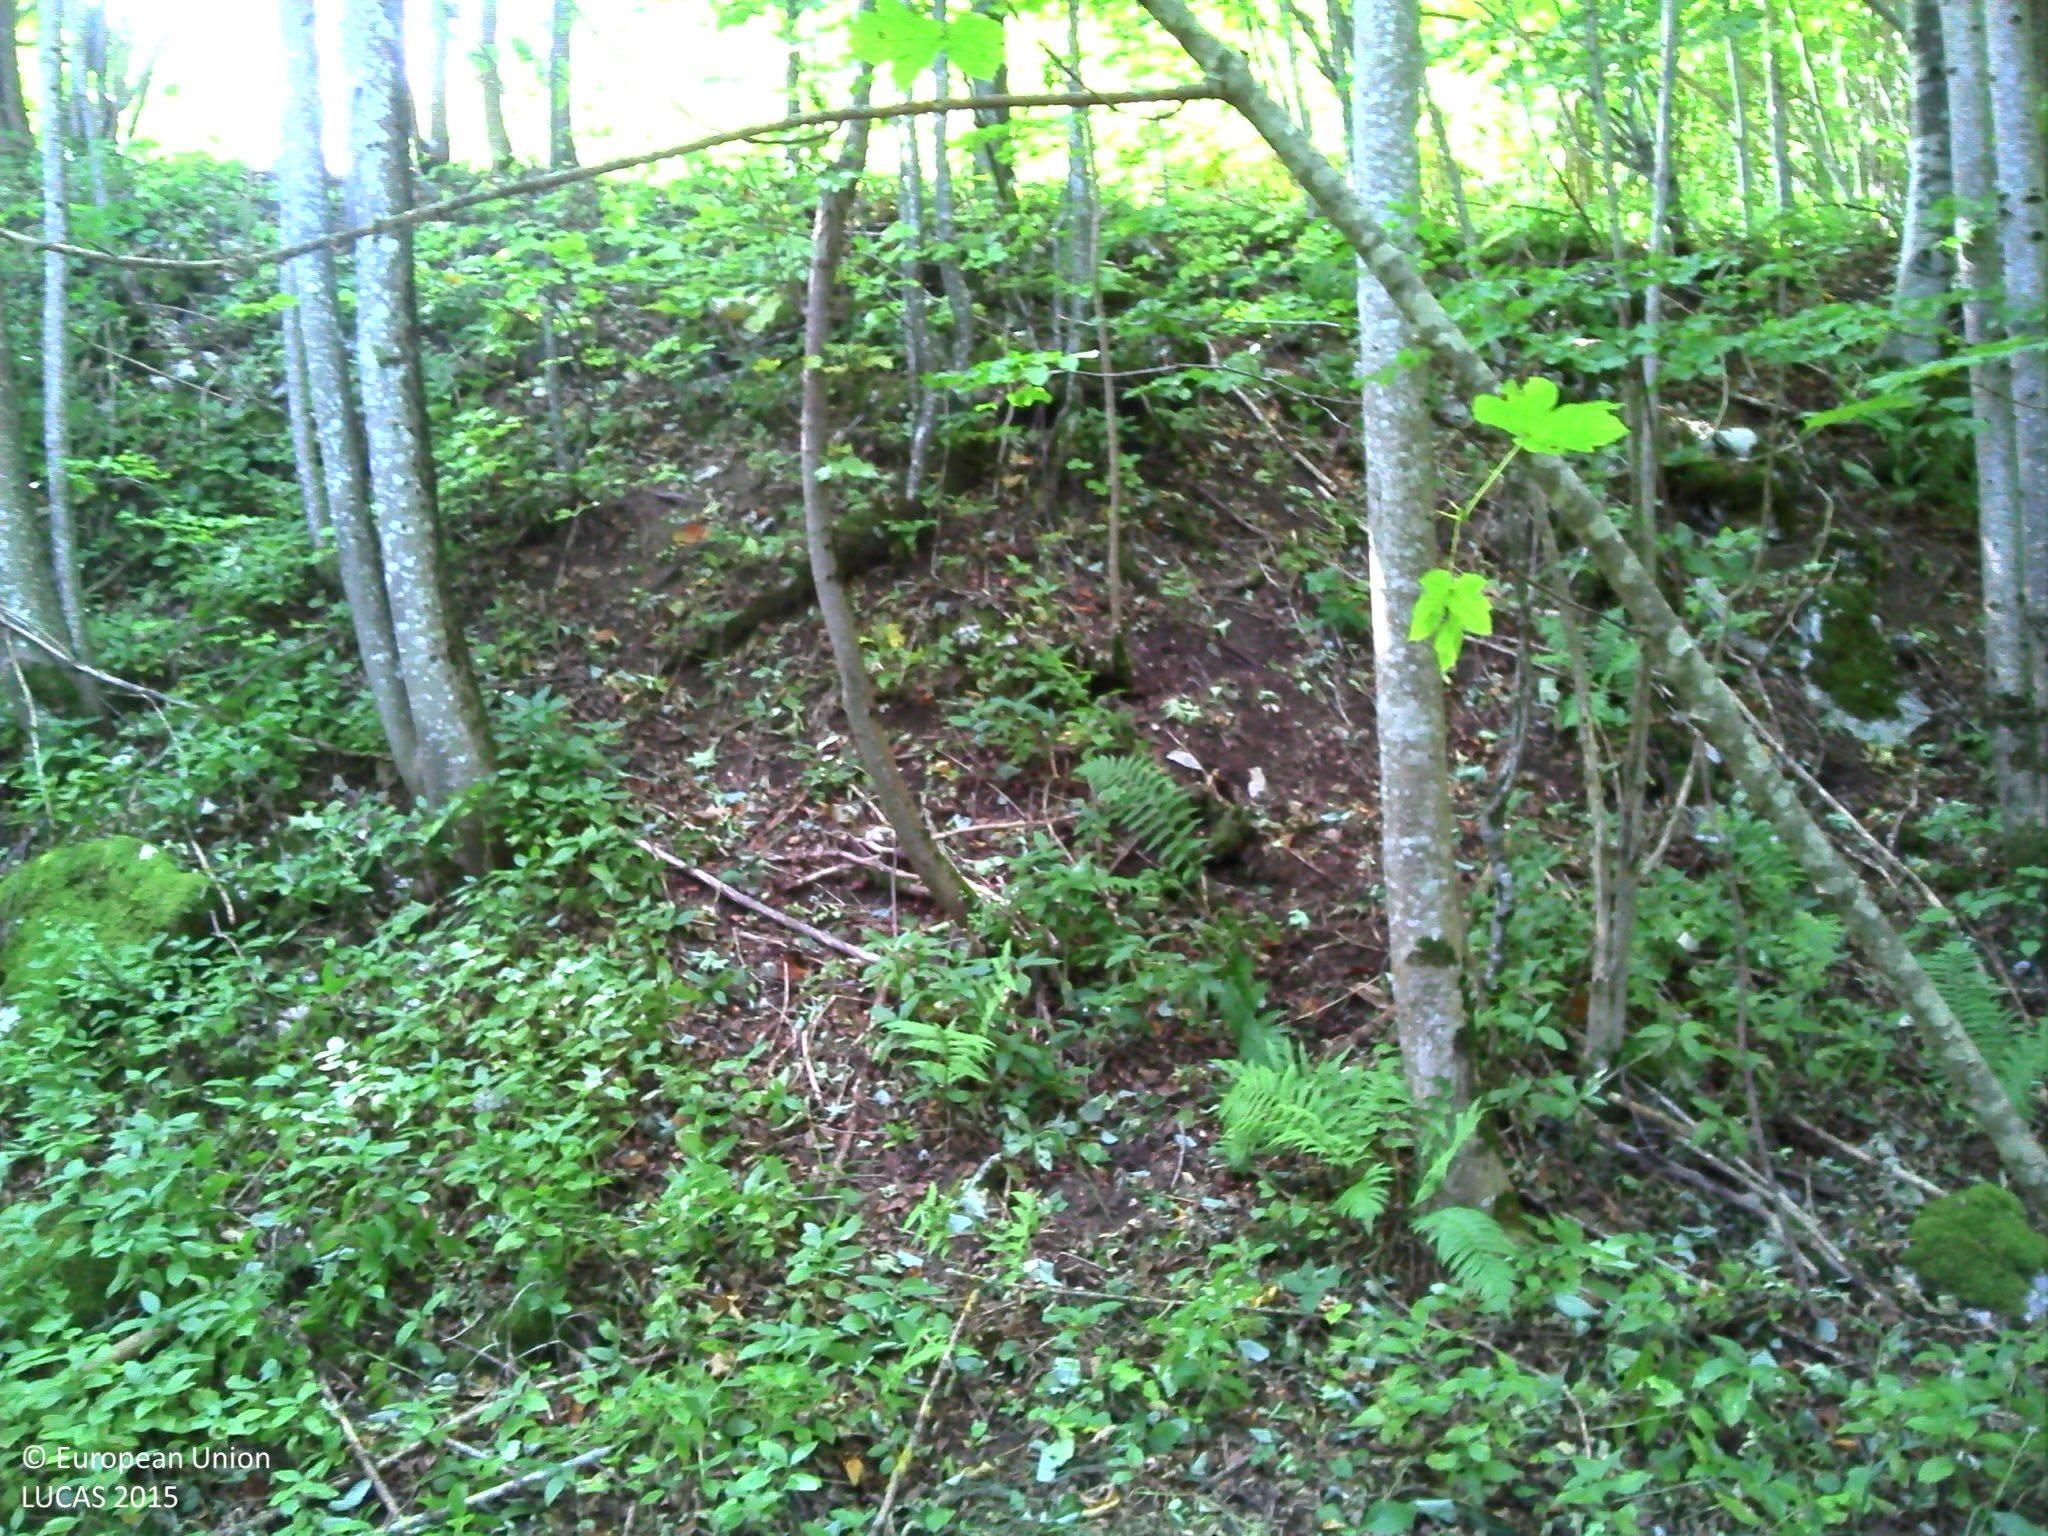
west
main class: Woodland
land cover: Broadleaved woodland
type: mesophytic deciduous forest
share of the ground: > 75 %
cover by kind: broadleaved forest trees 90 %, herbaceous plants 10 %
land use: Forestry
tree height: > 5 m
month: October
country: FR
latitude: 47.0112
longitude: 6.3849
